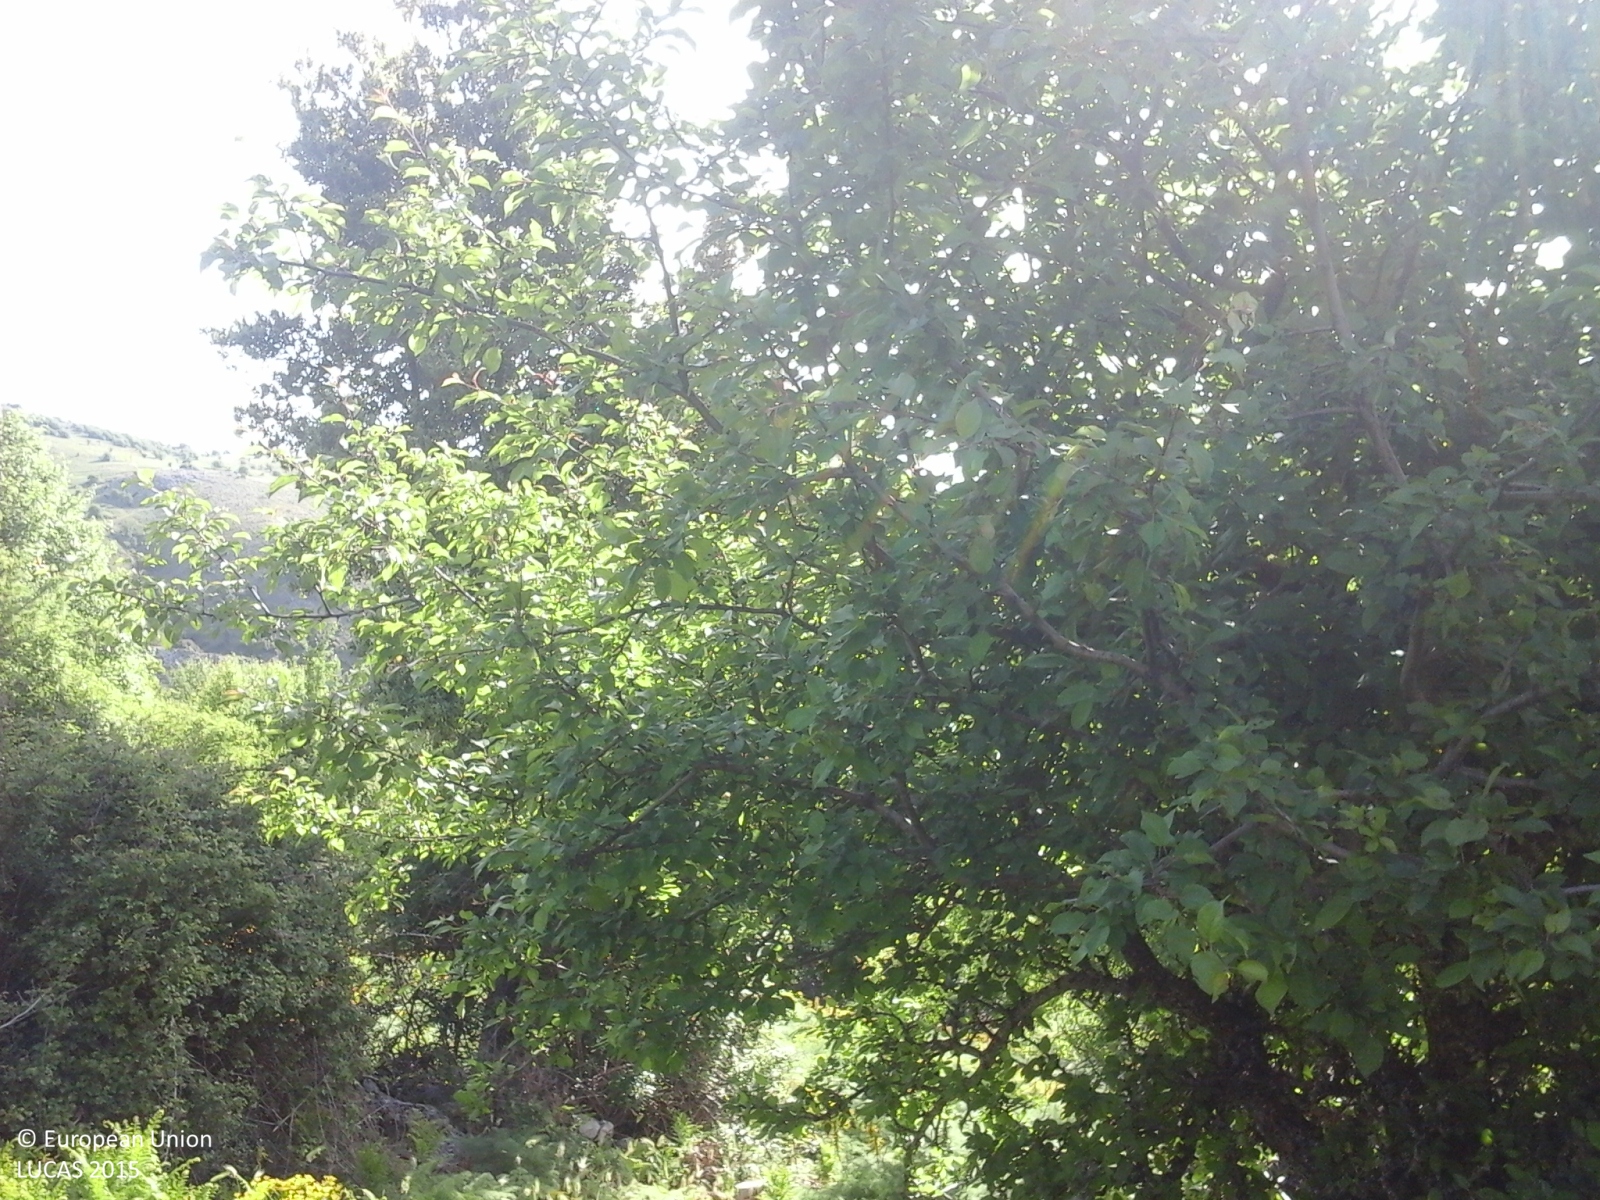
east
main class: Grassland
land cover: Grassland with sparse tree/shrub cover
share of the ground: > 75 %
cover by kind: herbaceous plants 70 %, consolidated bare surface 15 %, shrubs 10 %, broadleaved forest trees 5 %
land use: Agriculture (excluding fallow land and kitchen gardens)
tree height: < 5 m
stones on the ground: 25 - 50 %
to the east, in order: Grassland with sparse tree/shrub cover; Tracks; Grassland with sparse tree/shrub cover; Fences; Broadleaved woodland; Rivers and streams; Broadleaved woodland; Grassland with sparse tree/shrub cover; Shrubland with sparse tree cover
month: May
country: IT
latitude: 37.8611
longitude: 14.0519
